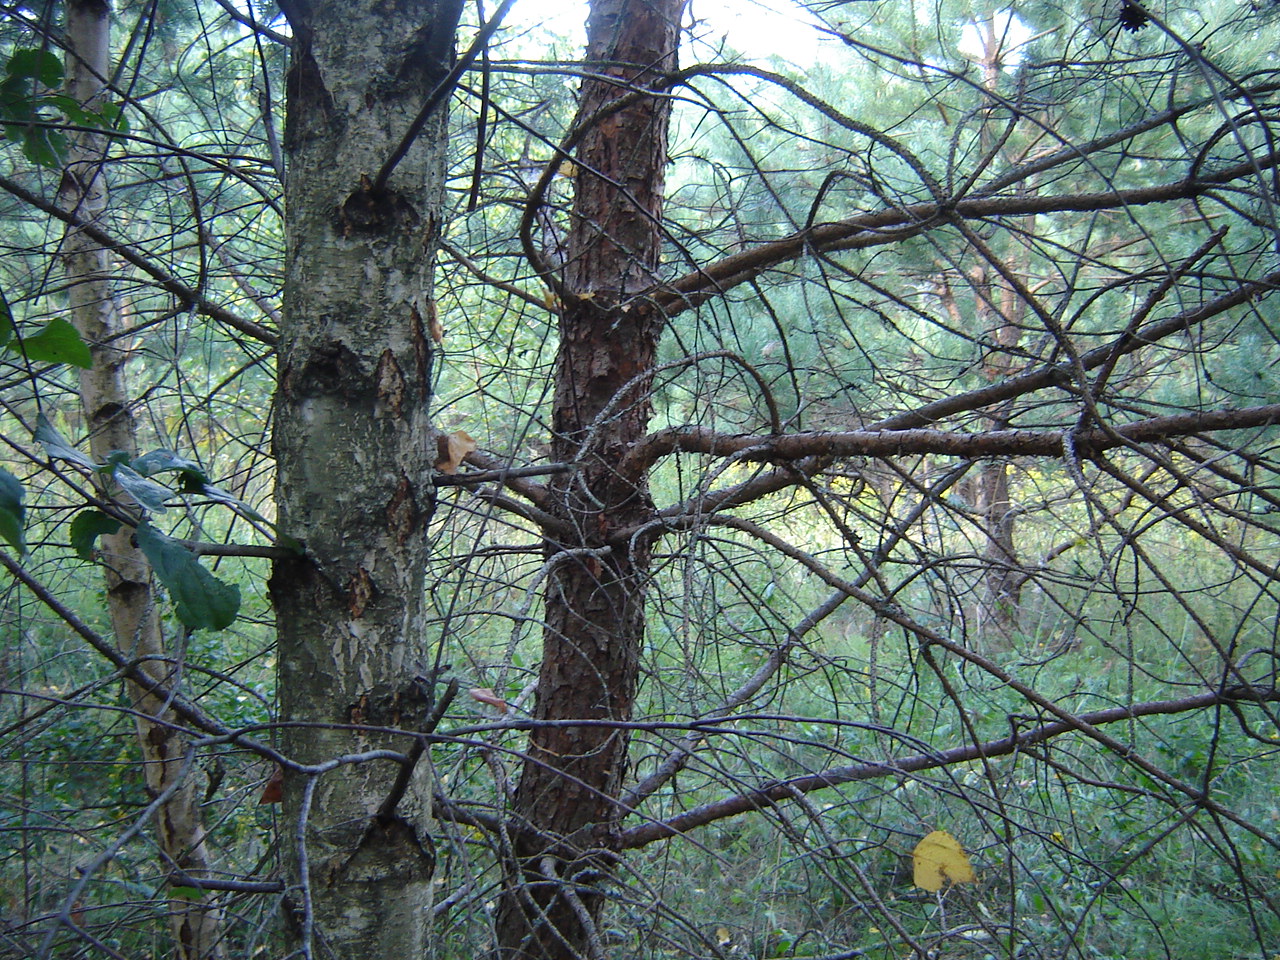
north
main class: Woodland
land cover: Pine dominated mixed woodland
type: hemiboreal forest and nemoral coniferous forest and mixed broadleaved-coniferous forest
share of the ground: > 75 %
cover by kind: coniferous forest trees 55 %, broadleaved forest trees 40 %, herbaceous plants 5 %
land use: Forestry
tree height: > 5 m
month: August
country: LT
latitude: 54.7936
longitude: 24.9347
